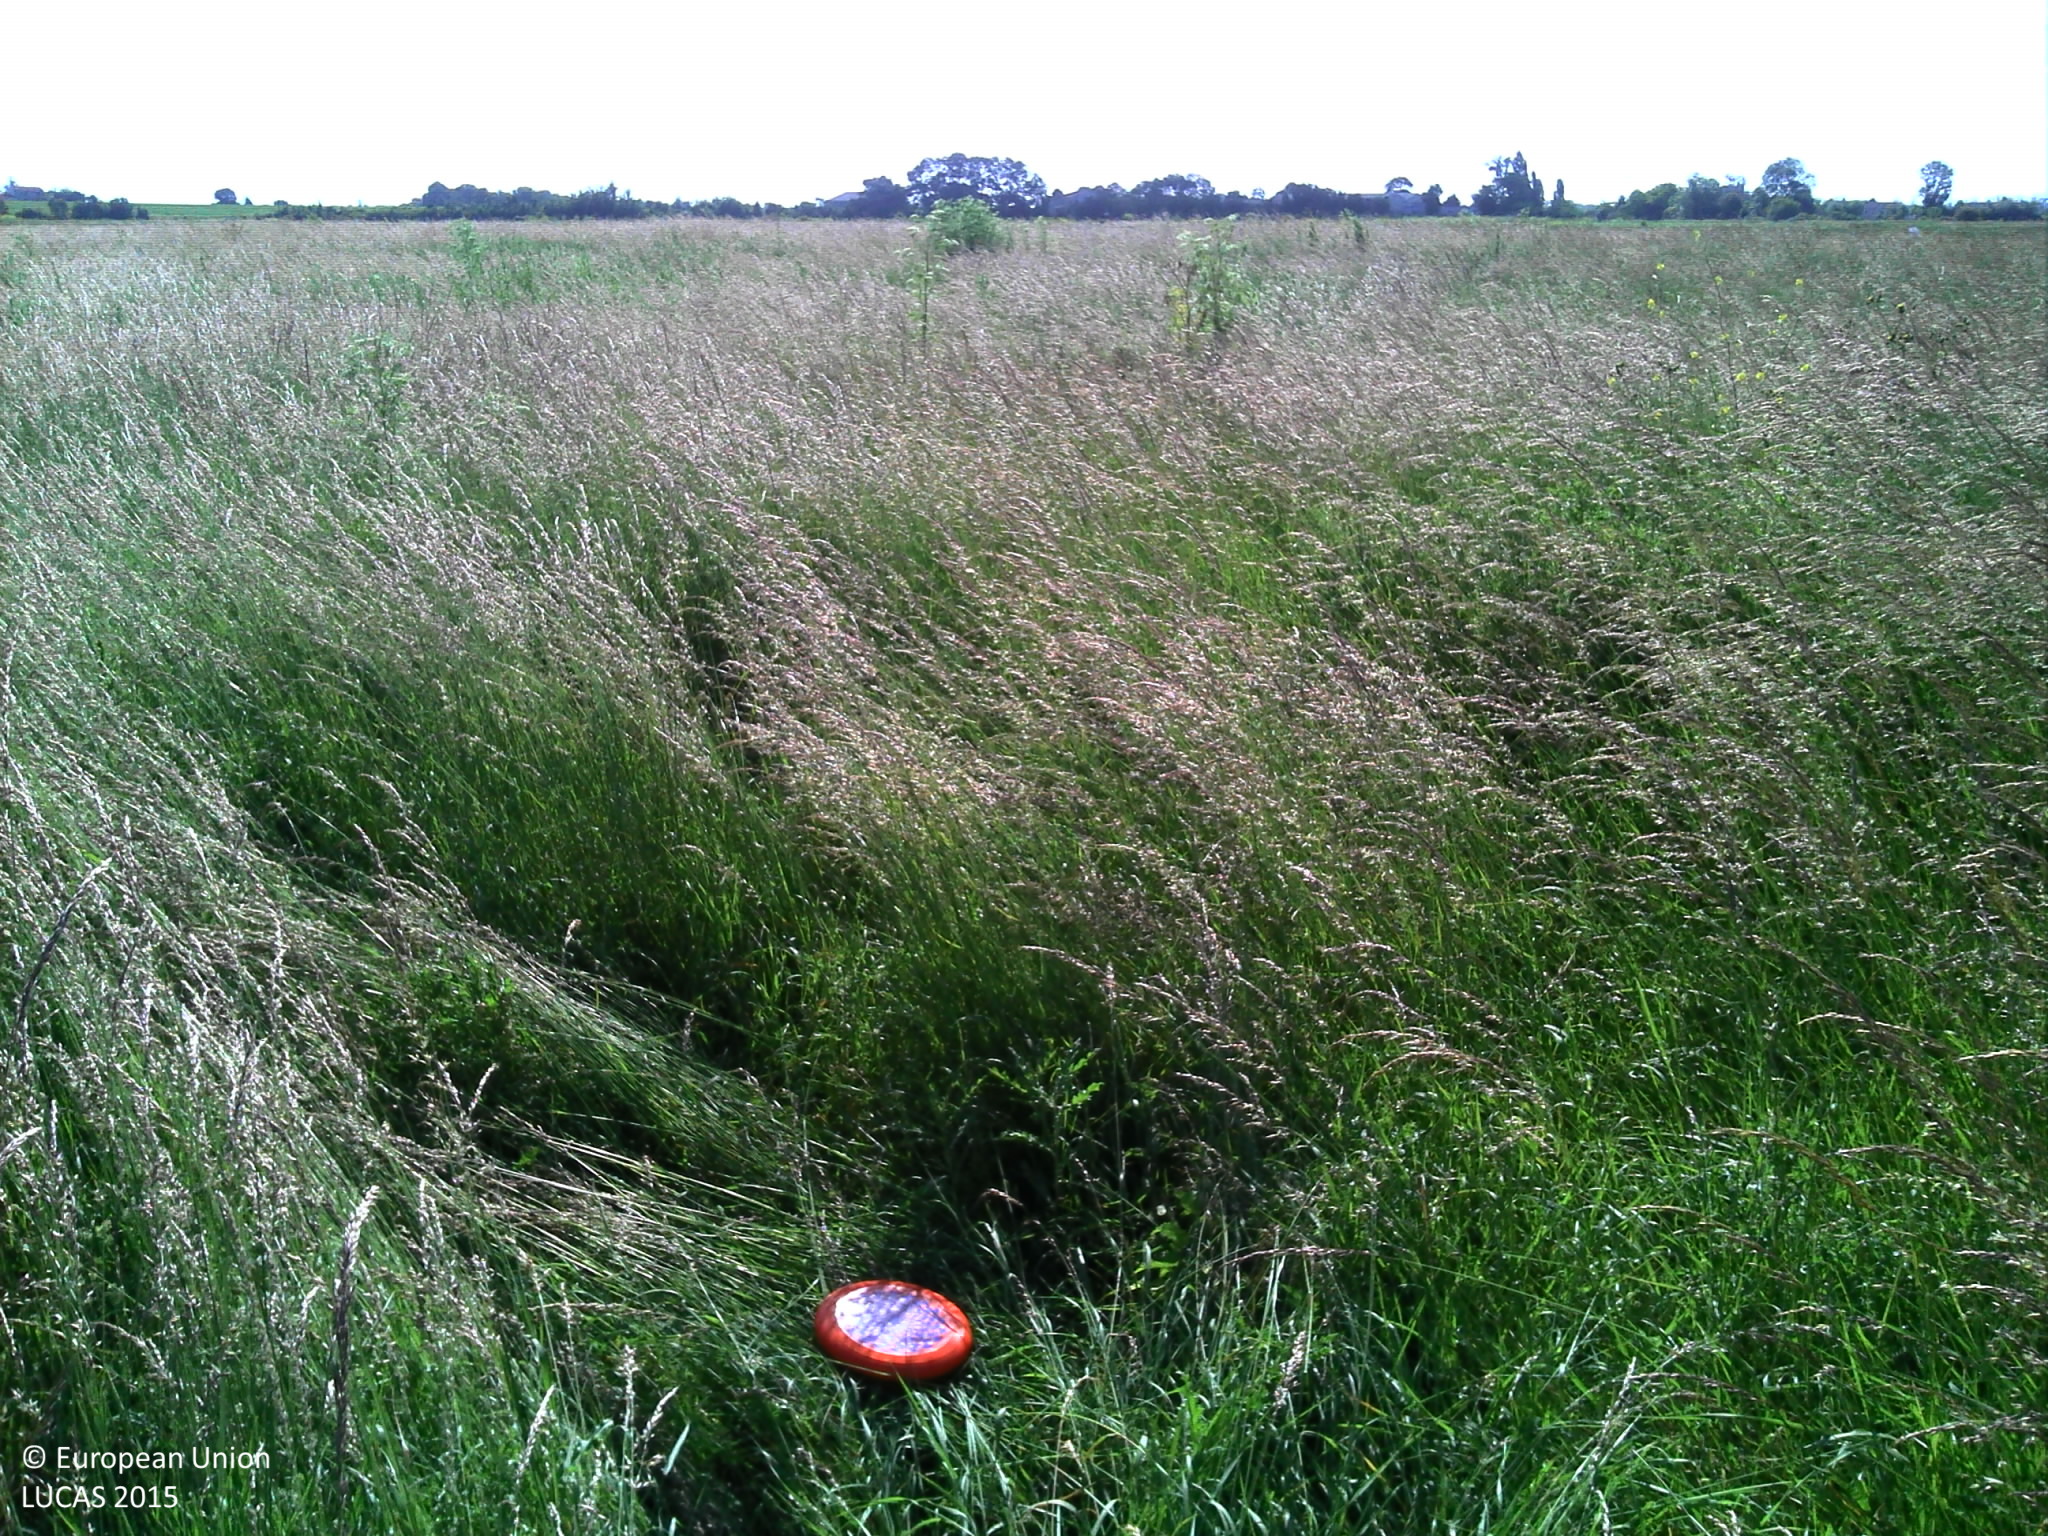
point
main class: Grassland
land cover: Grassland without tree/shrub cover
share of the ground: > 75 %
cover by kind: herbaceous plants 100 %
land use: Agriculture (excluding fallow land and kitchen gardens)
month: June
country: FR
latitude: 46.2473
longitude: -1.0691
